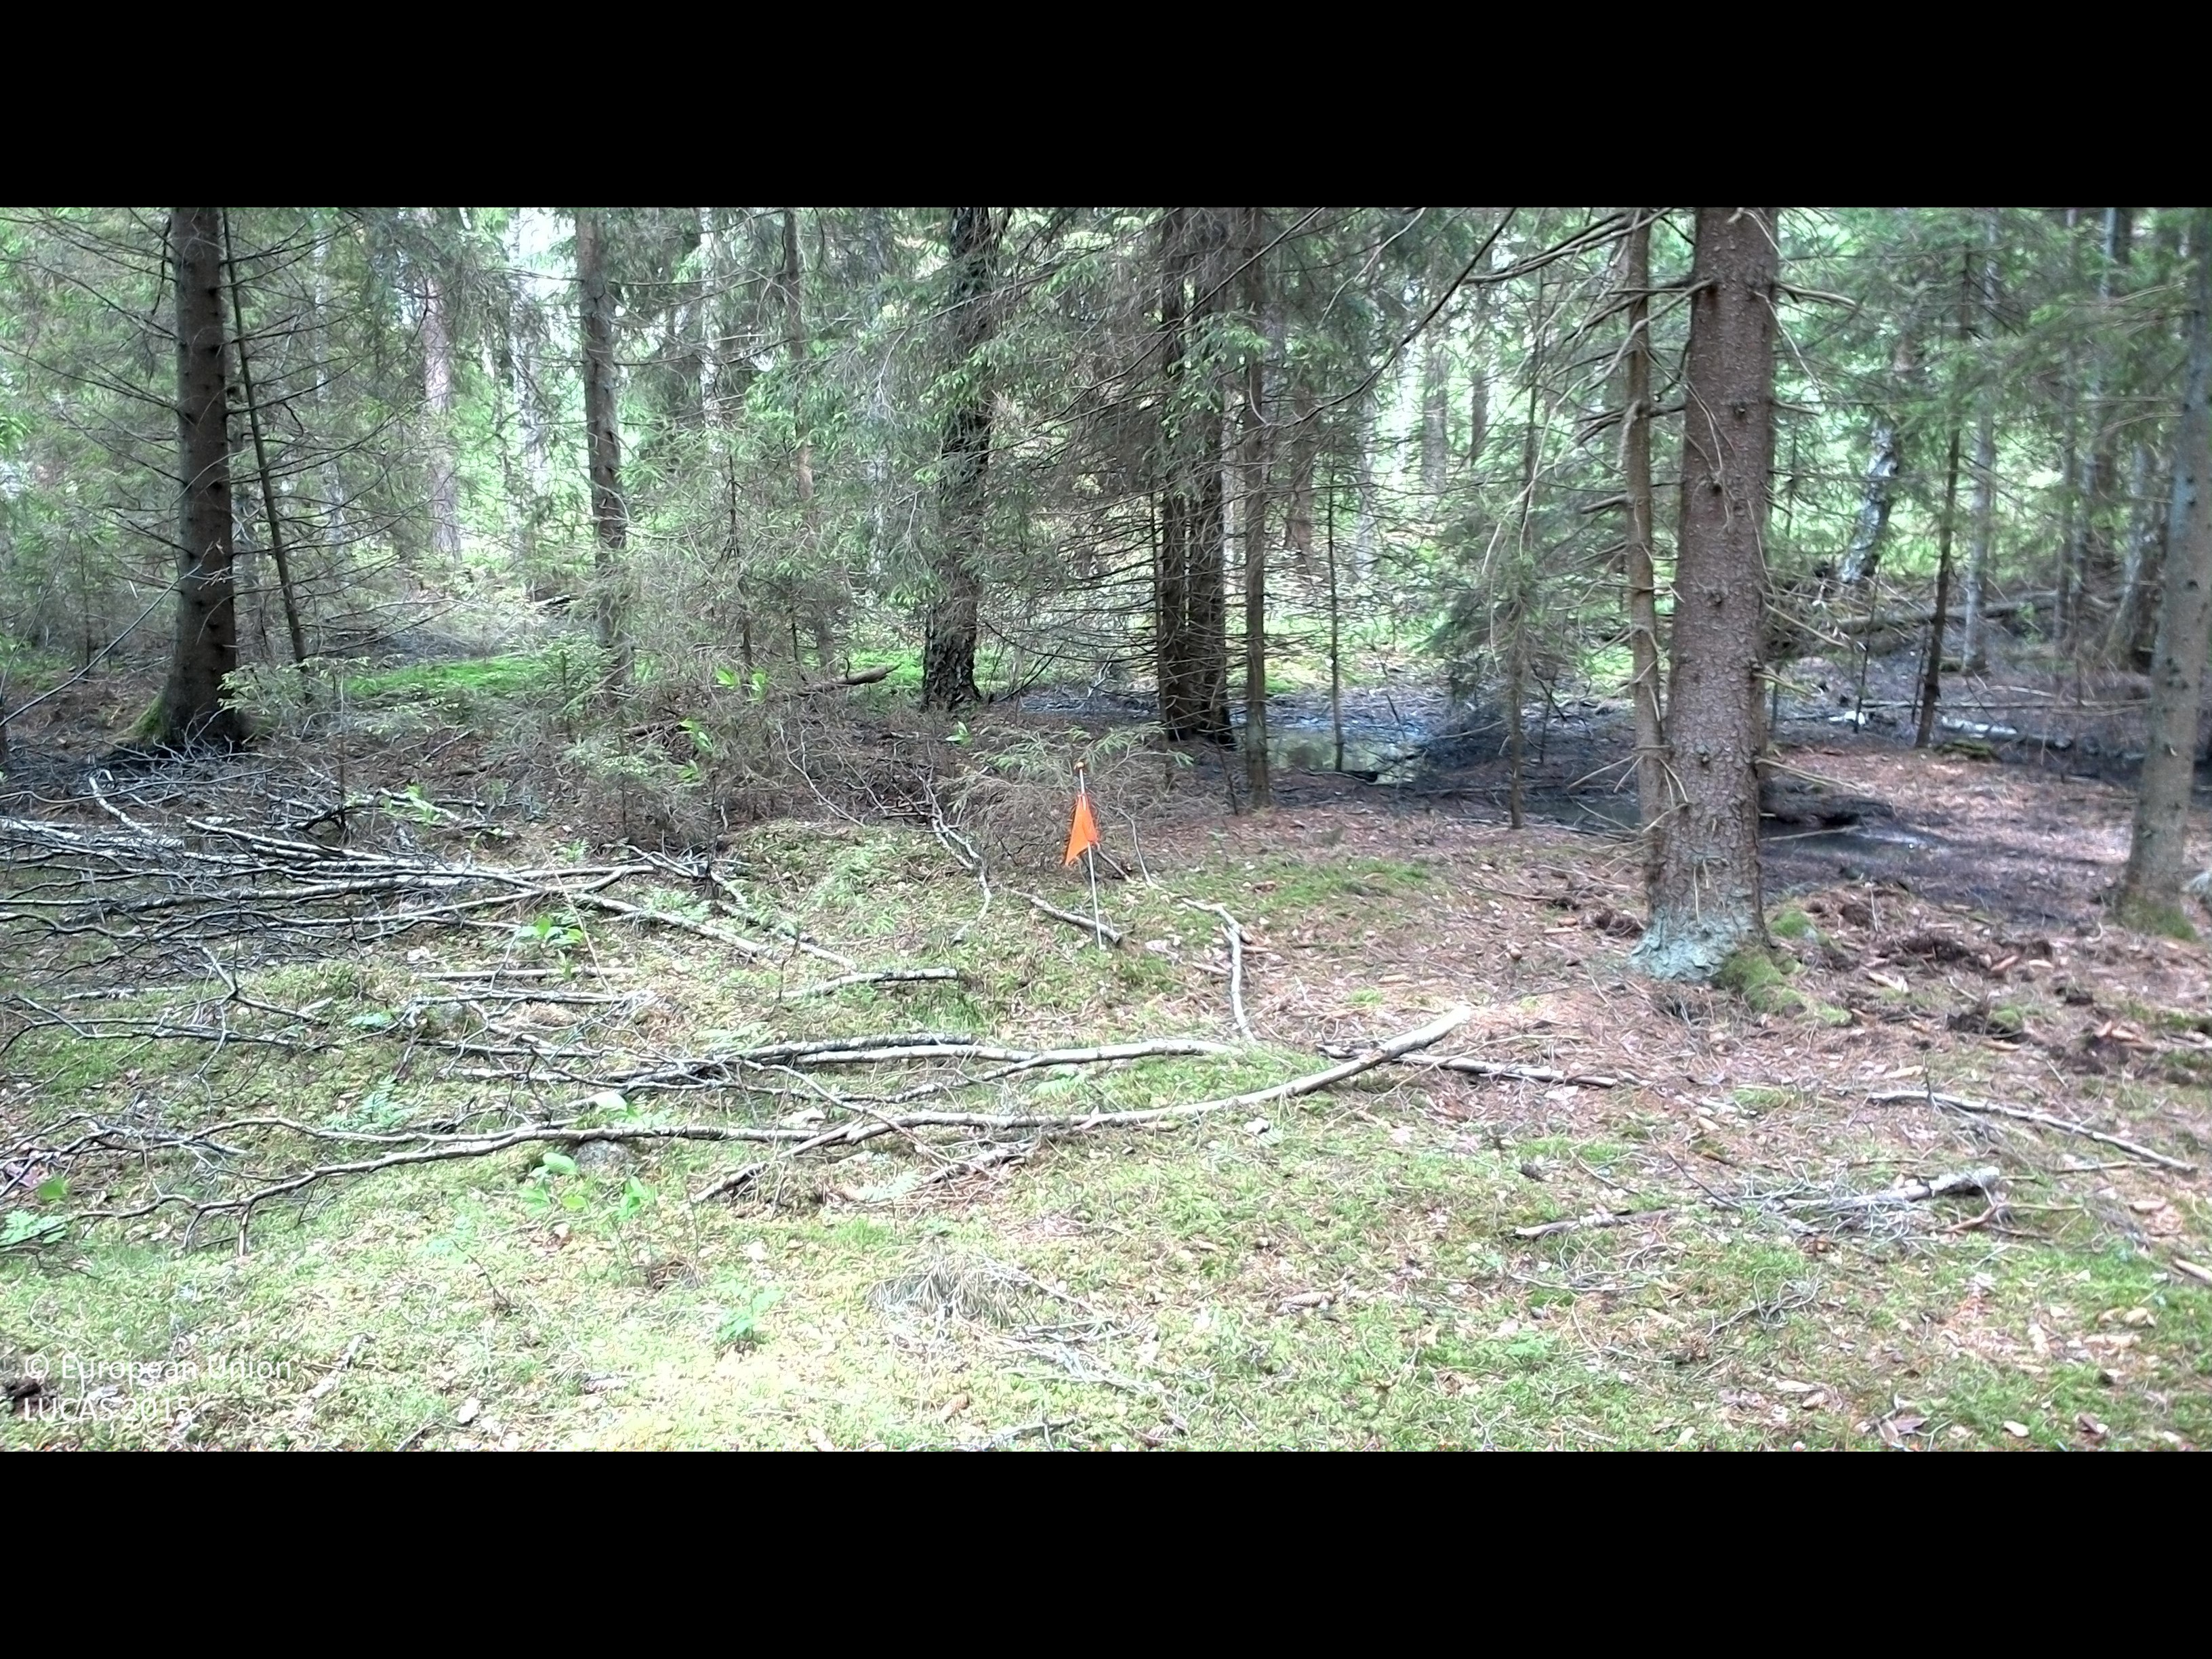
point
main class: Woodland
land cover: Spruce dominated coniferous woodland
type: boreal forest
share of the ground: > 75 %
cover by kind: coniferous forest trees 75 %, lichens and mosses 15 %, broadleaved forest trees 10 %
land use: Forestry
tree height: > 5 m
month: June
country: SE
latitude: 56.4314
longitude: 15.8865
